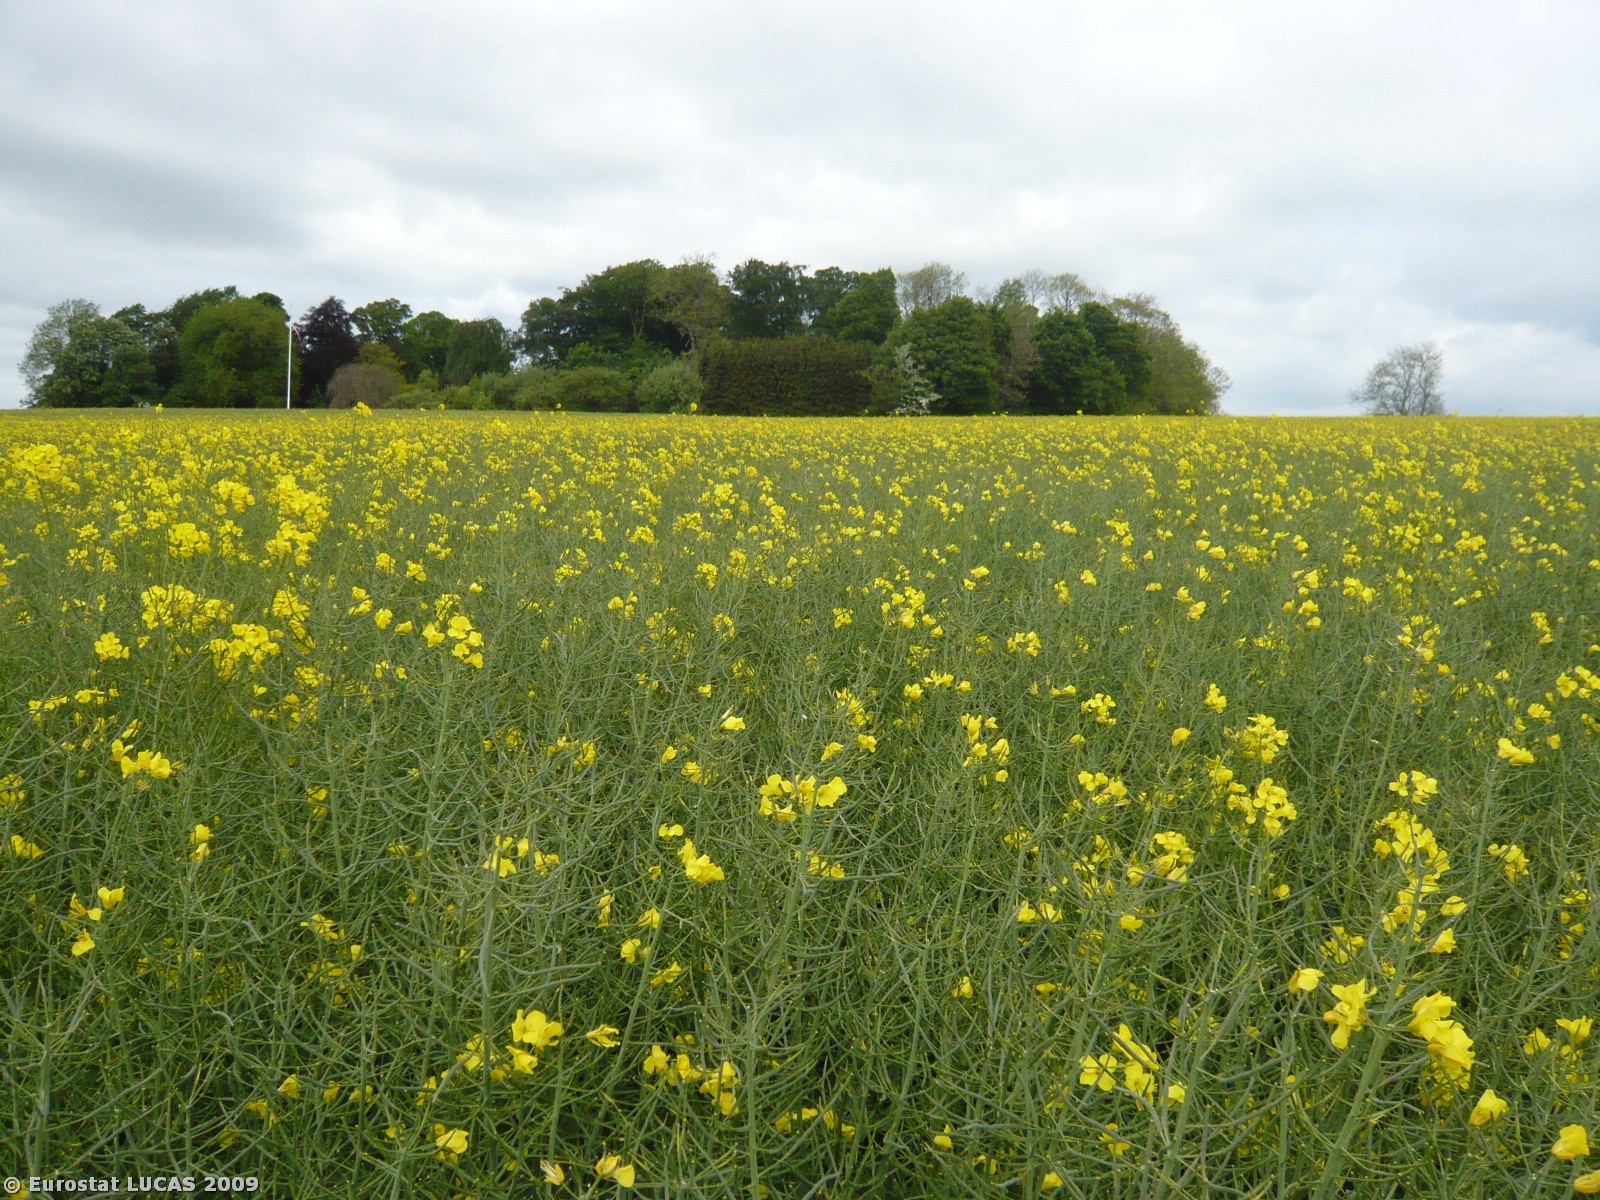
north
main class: Cropland
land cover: Rape and turnip rape
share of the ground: > 75 %
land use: Agriculture (excluding fallow land and kitchen gardens)
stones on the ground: < 10 %
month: May
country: DK
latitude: 55.4215
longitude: 11.6891
